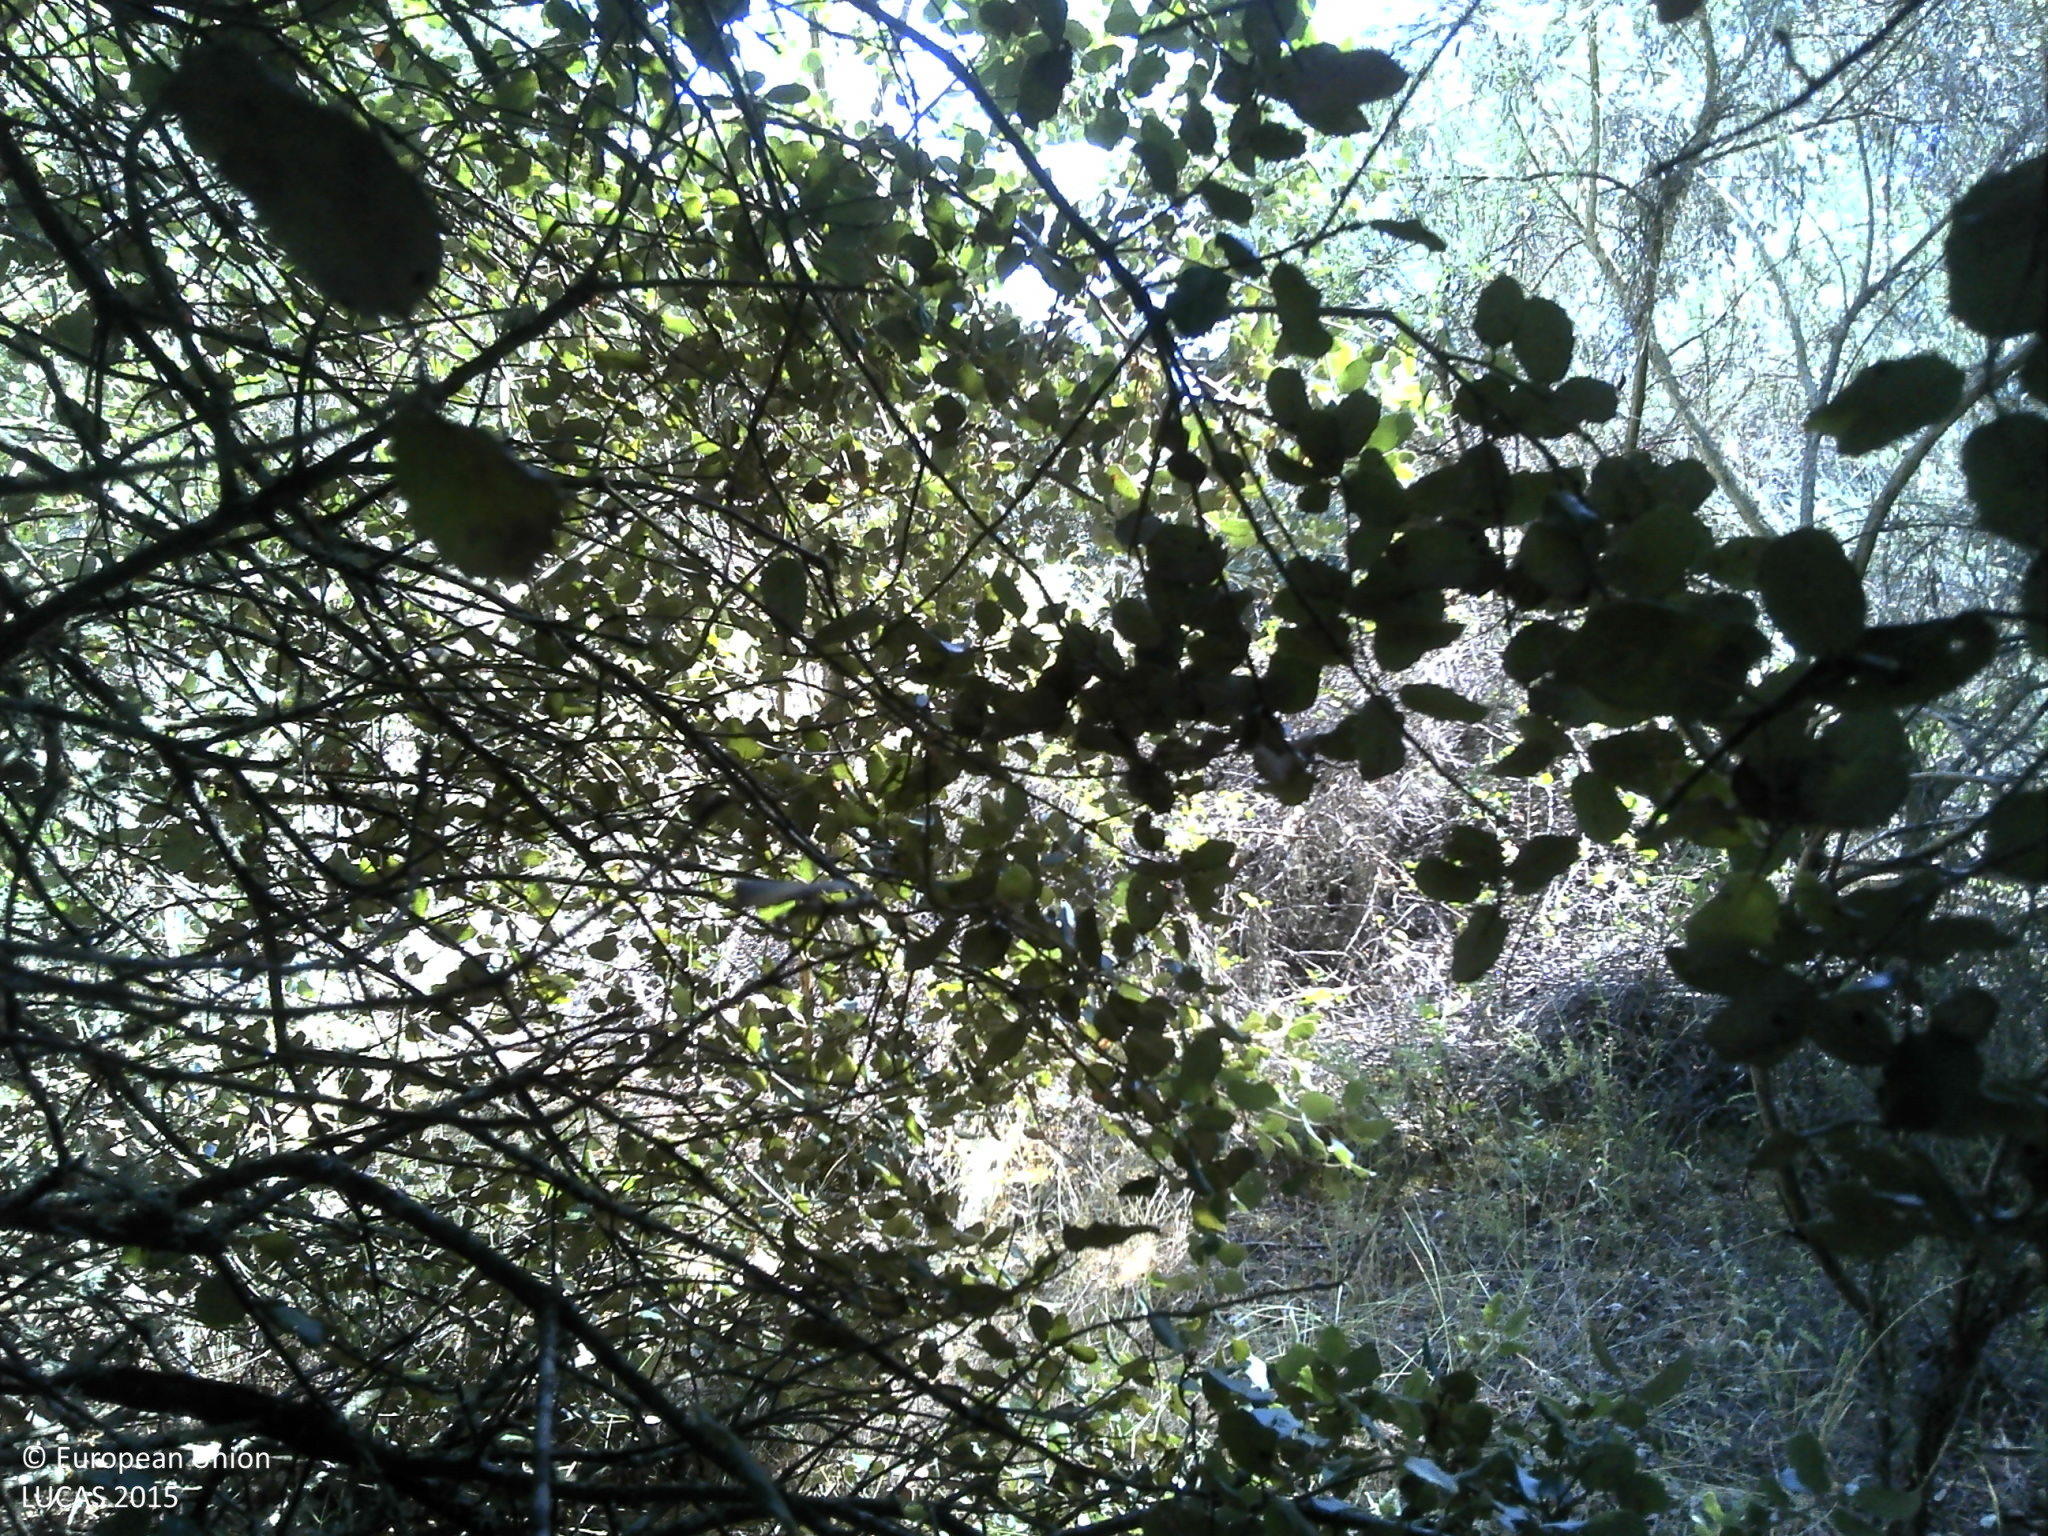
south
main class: Woodland
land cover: Broadleaved woodland
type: broadleaved evergreen forest
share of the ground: 25 - 50 %
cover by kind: shrubs 40 %, herbaceous plants 30 %, broadleaved forest trees 25 %, unconsolidated bare surface 5 %
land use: Forestry
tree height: > 5 m
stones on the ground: < 10 %
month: June
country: PT
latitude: 40.8556
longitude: -6.8875
